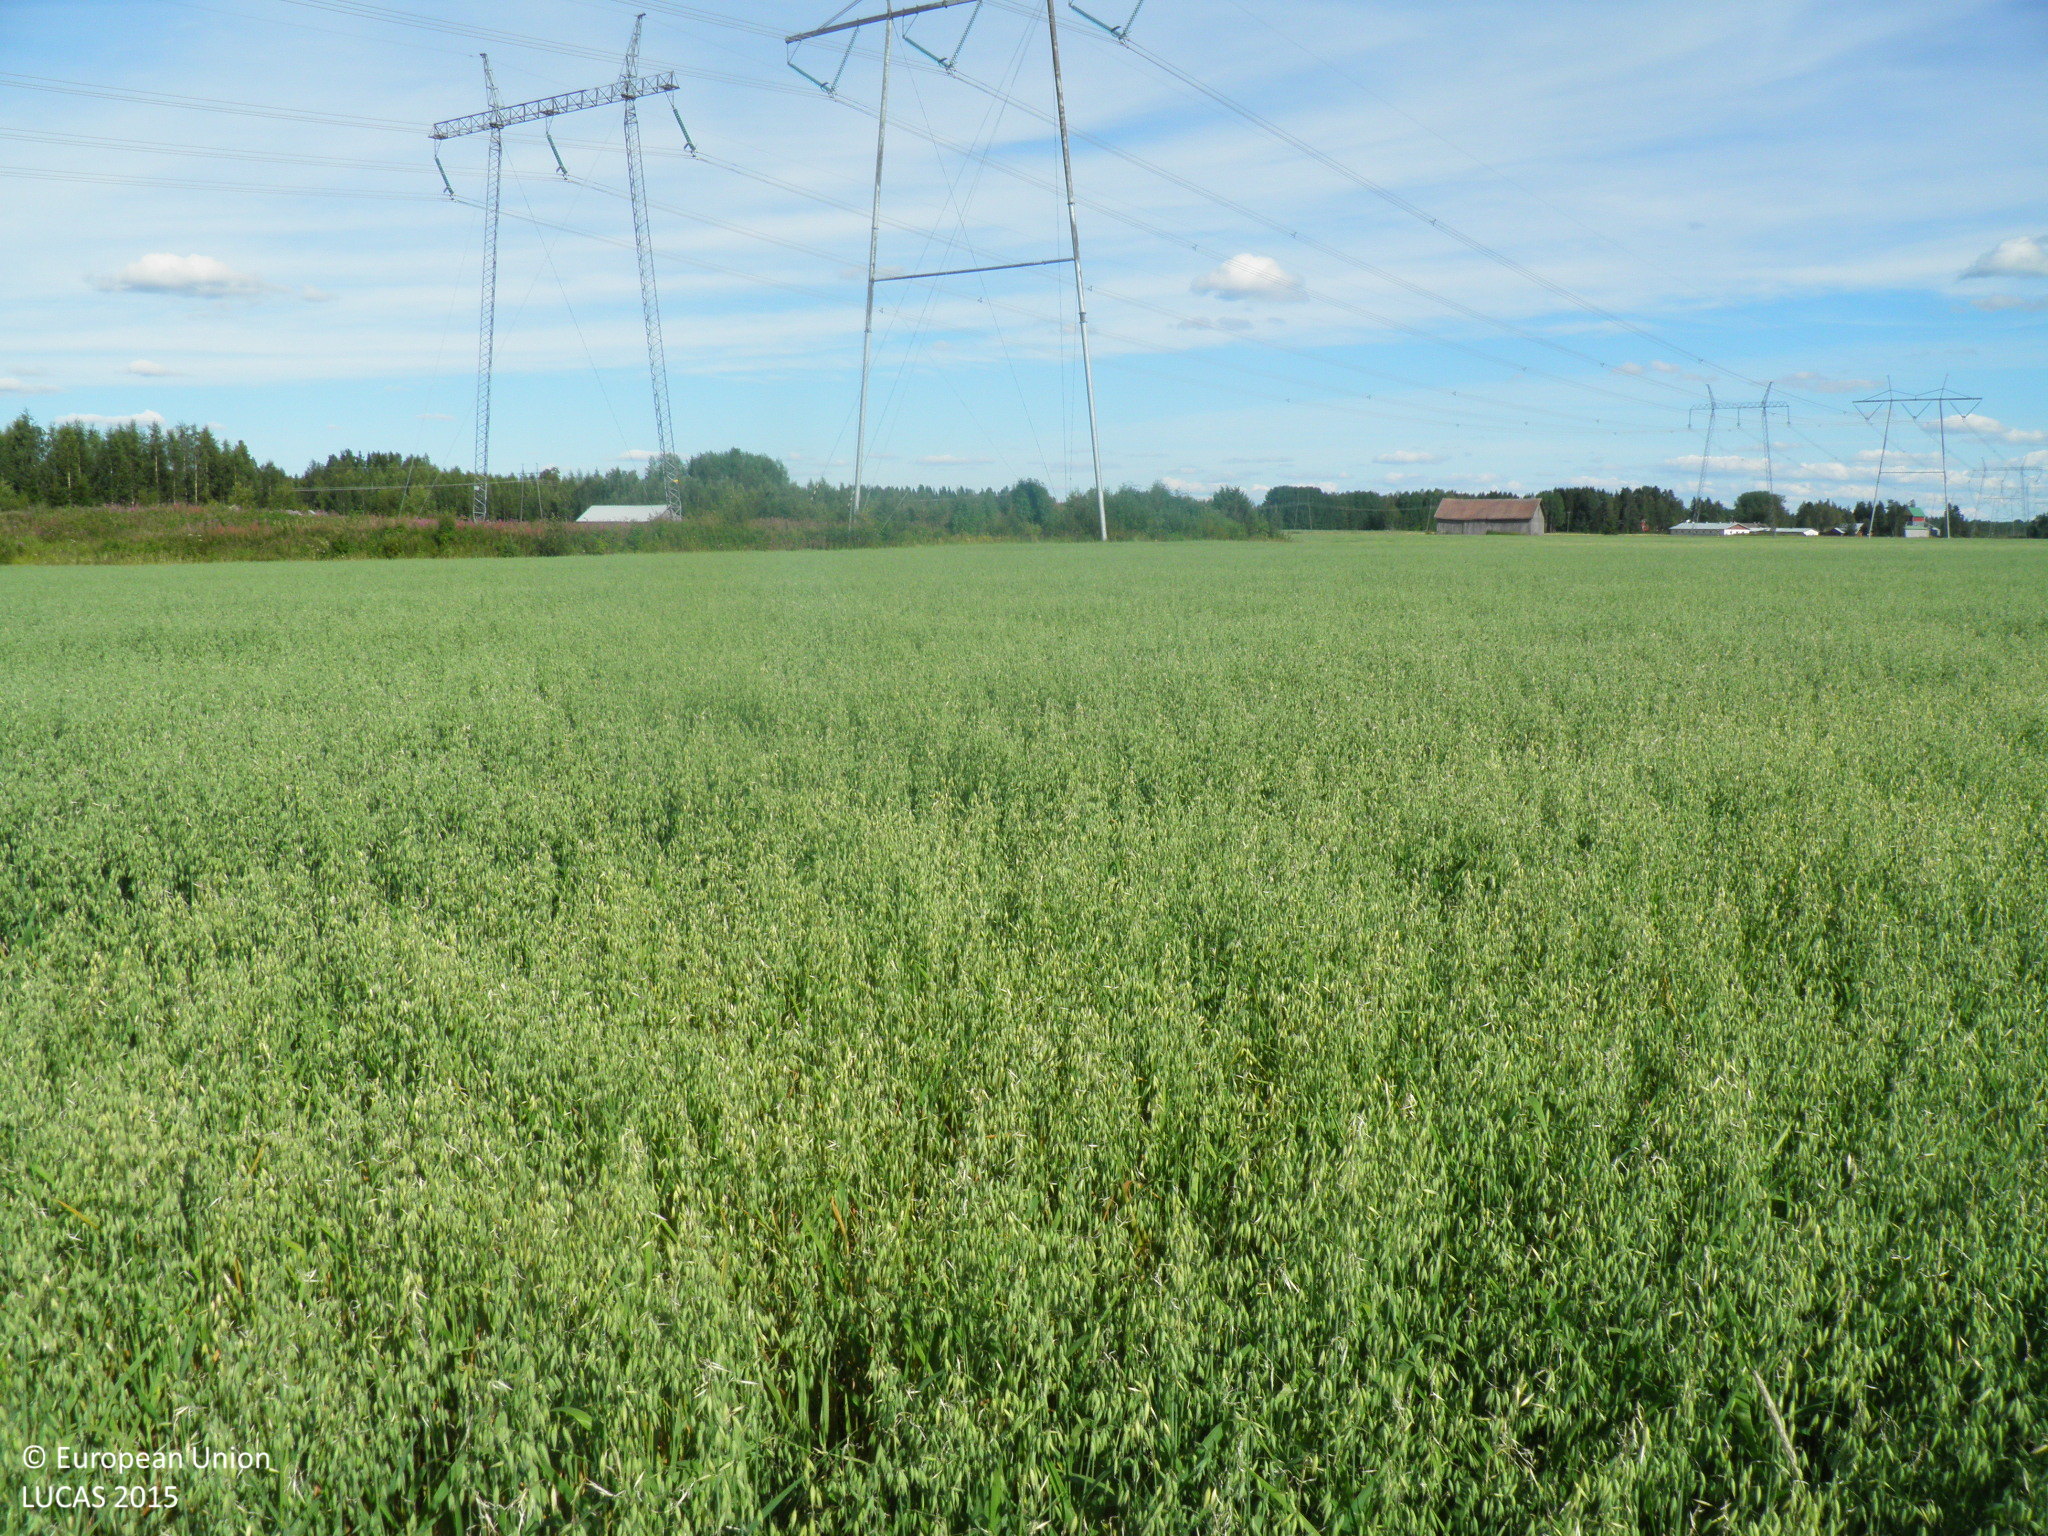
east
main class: Cropland
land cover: Oats
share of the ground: > 75 %
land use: Agriculture (excluding fallow land and kitchen gardens)
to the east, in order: Oats; Grass margins; Ditches and canals; Shrubland with sparse tree cover; Electric lines; Shrubland with sparse tree cover; Ditches and canals; Grass margins; Oats
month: August
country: FI
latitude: 61.1471
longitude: 22.6068
